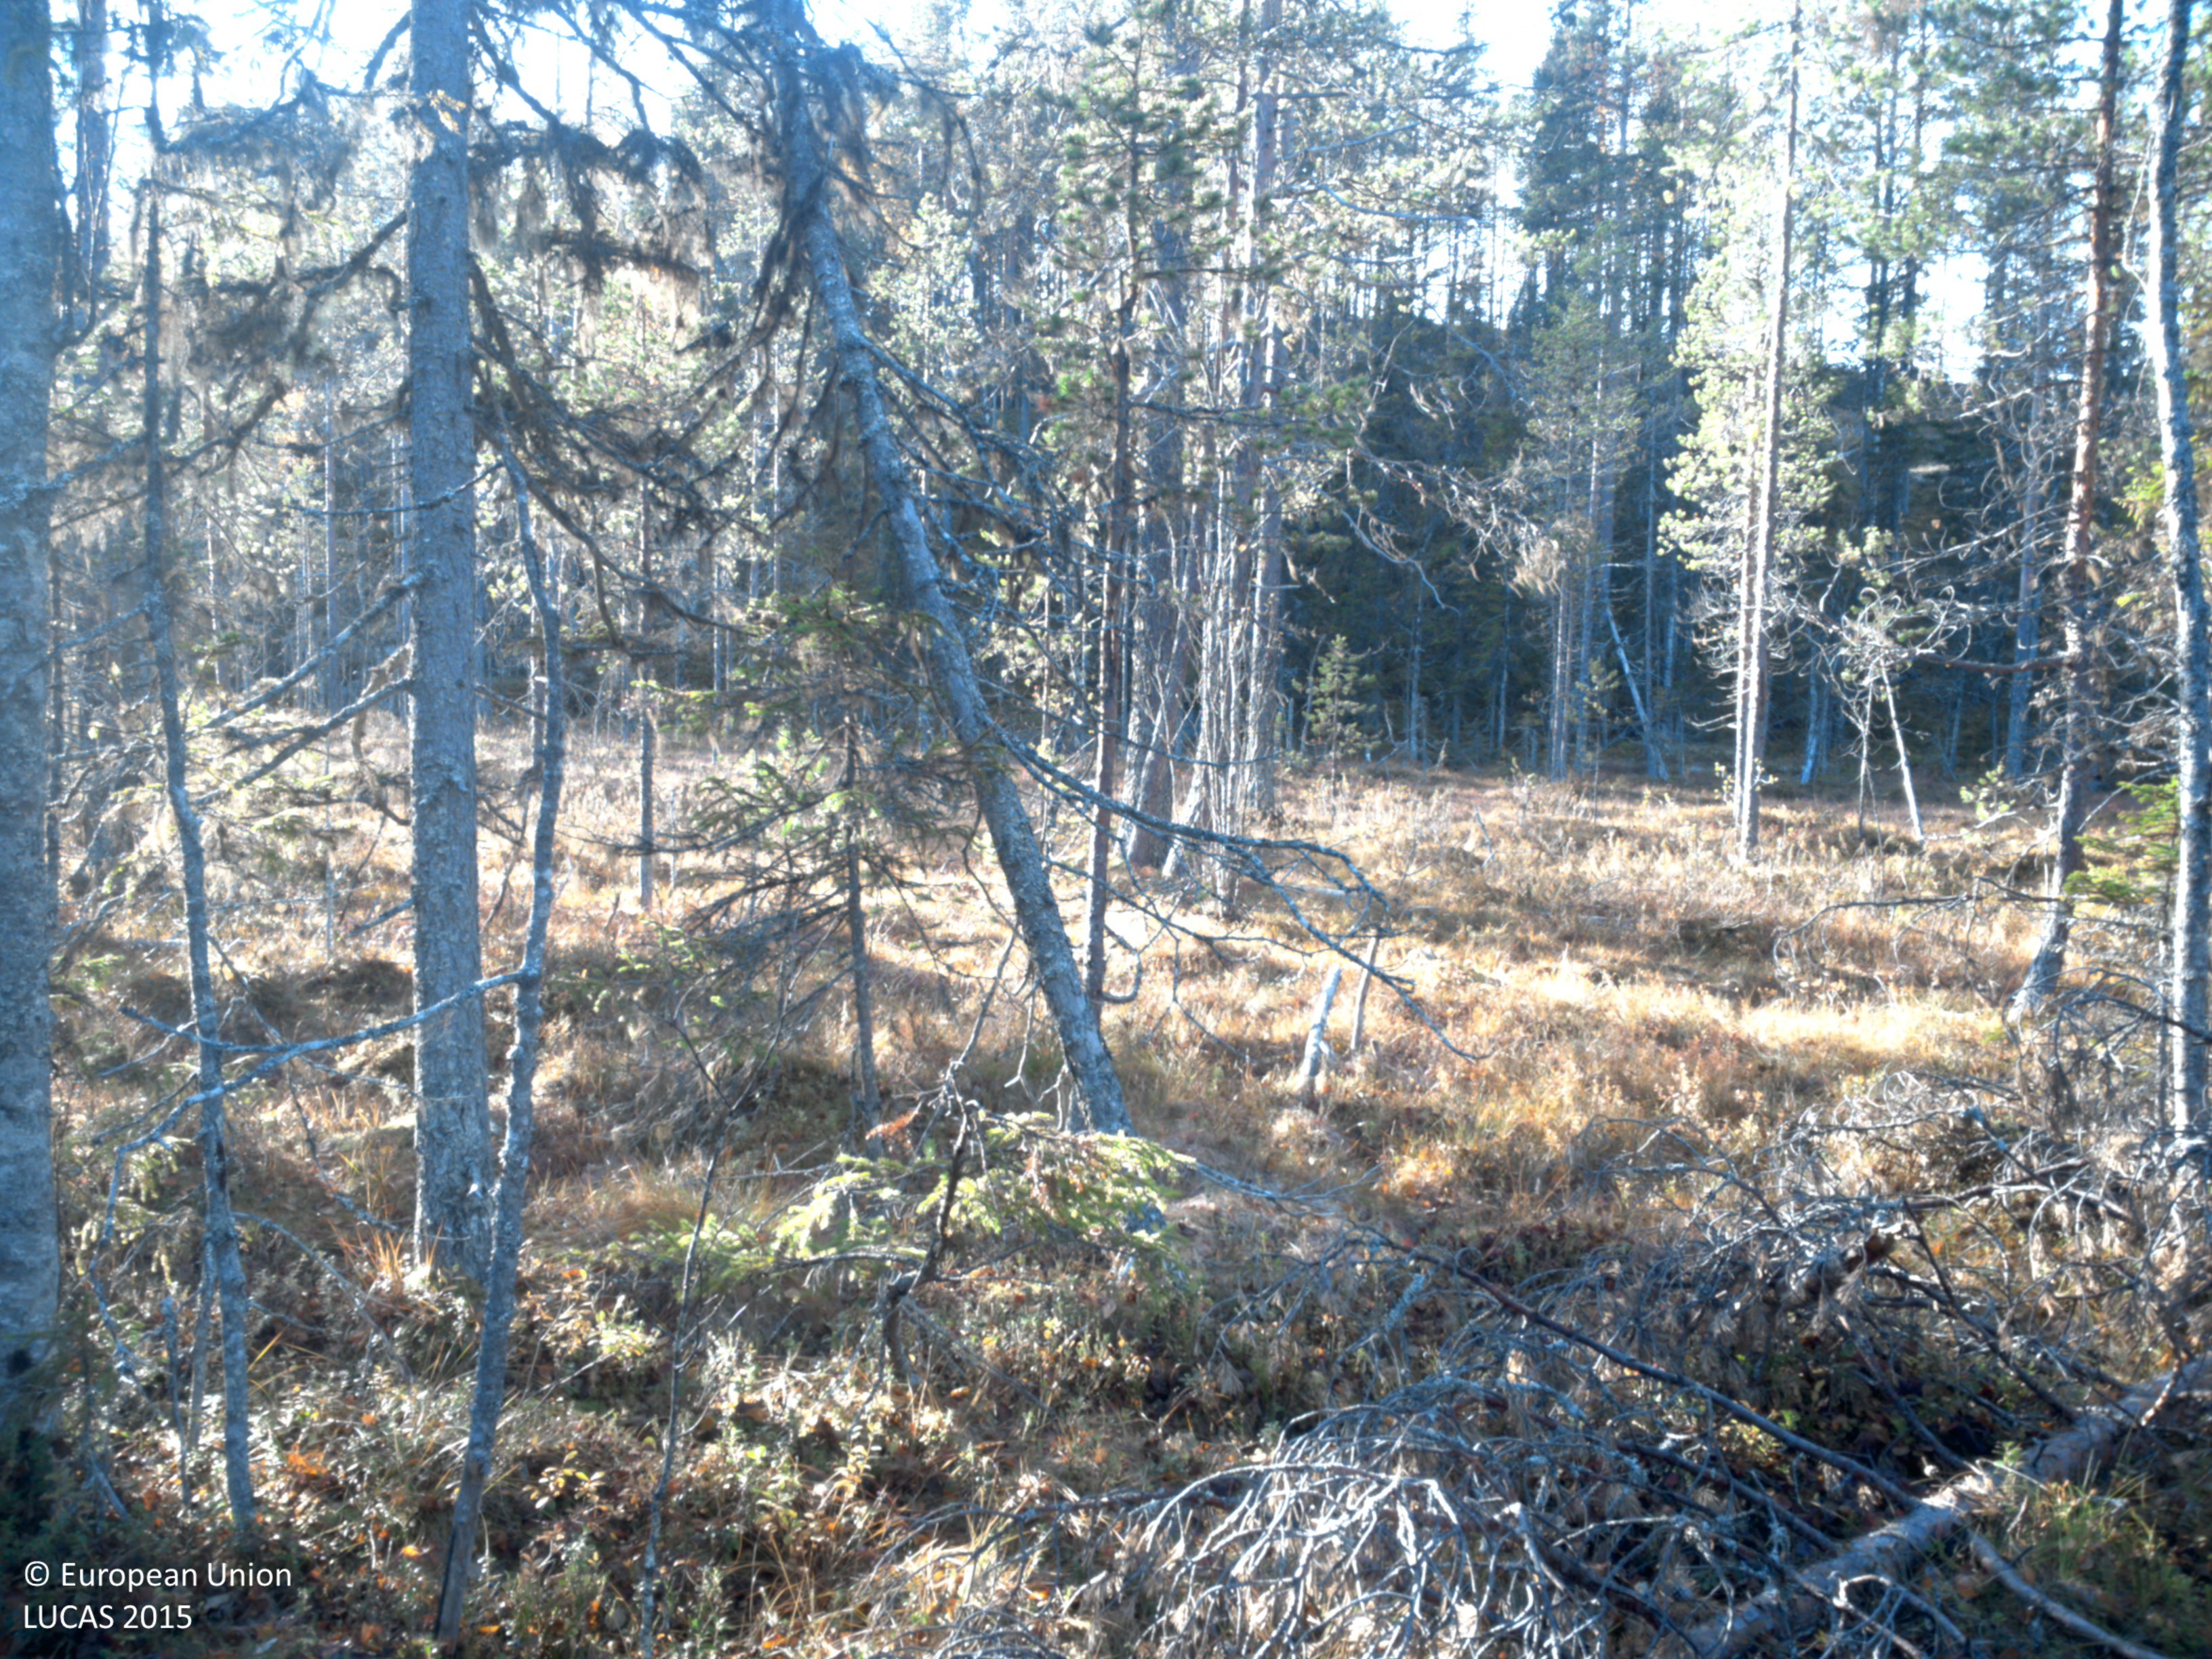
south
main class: Woodland
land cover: Spruce dominated mixed woodland
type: boreal forest
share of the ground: 50 - 75 %
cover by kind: coniferous forest trees 35 %, broadleaved forest trees 25 %, shrubs 20 %, herbaceous plants 10 %, lichens and mosses 10 %
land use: Forestry
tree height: > 5 m
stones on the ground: < 10 %
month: October
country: SE
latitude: 64.7353
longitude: 18.4711
